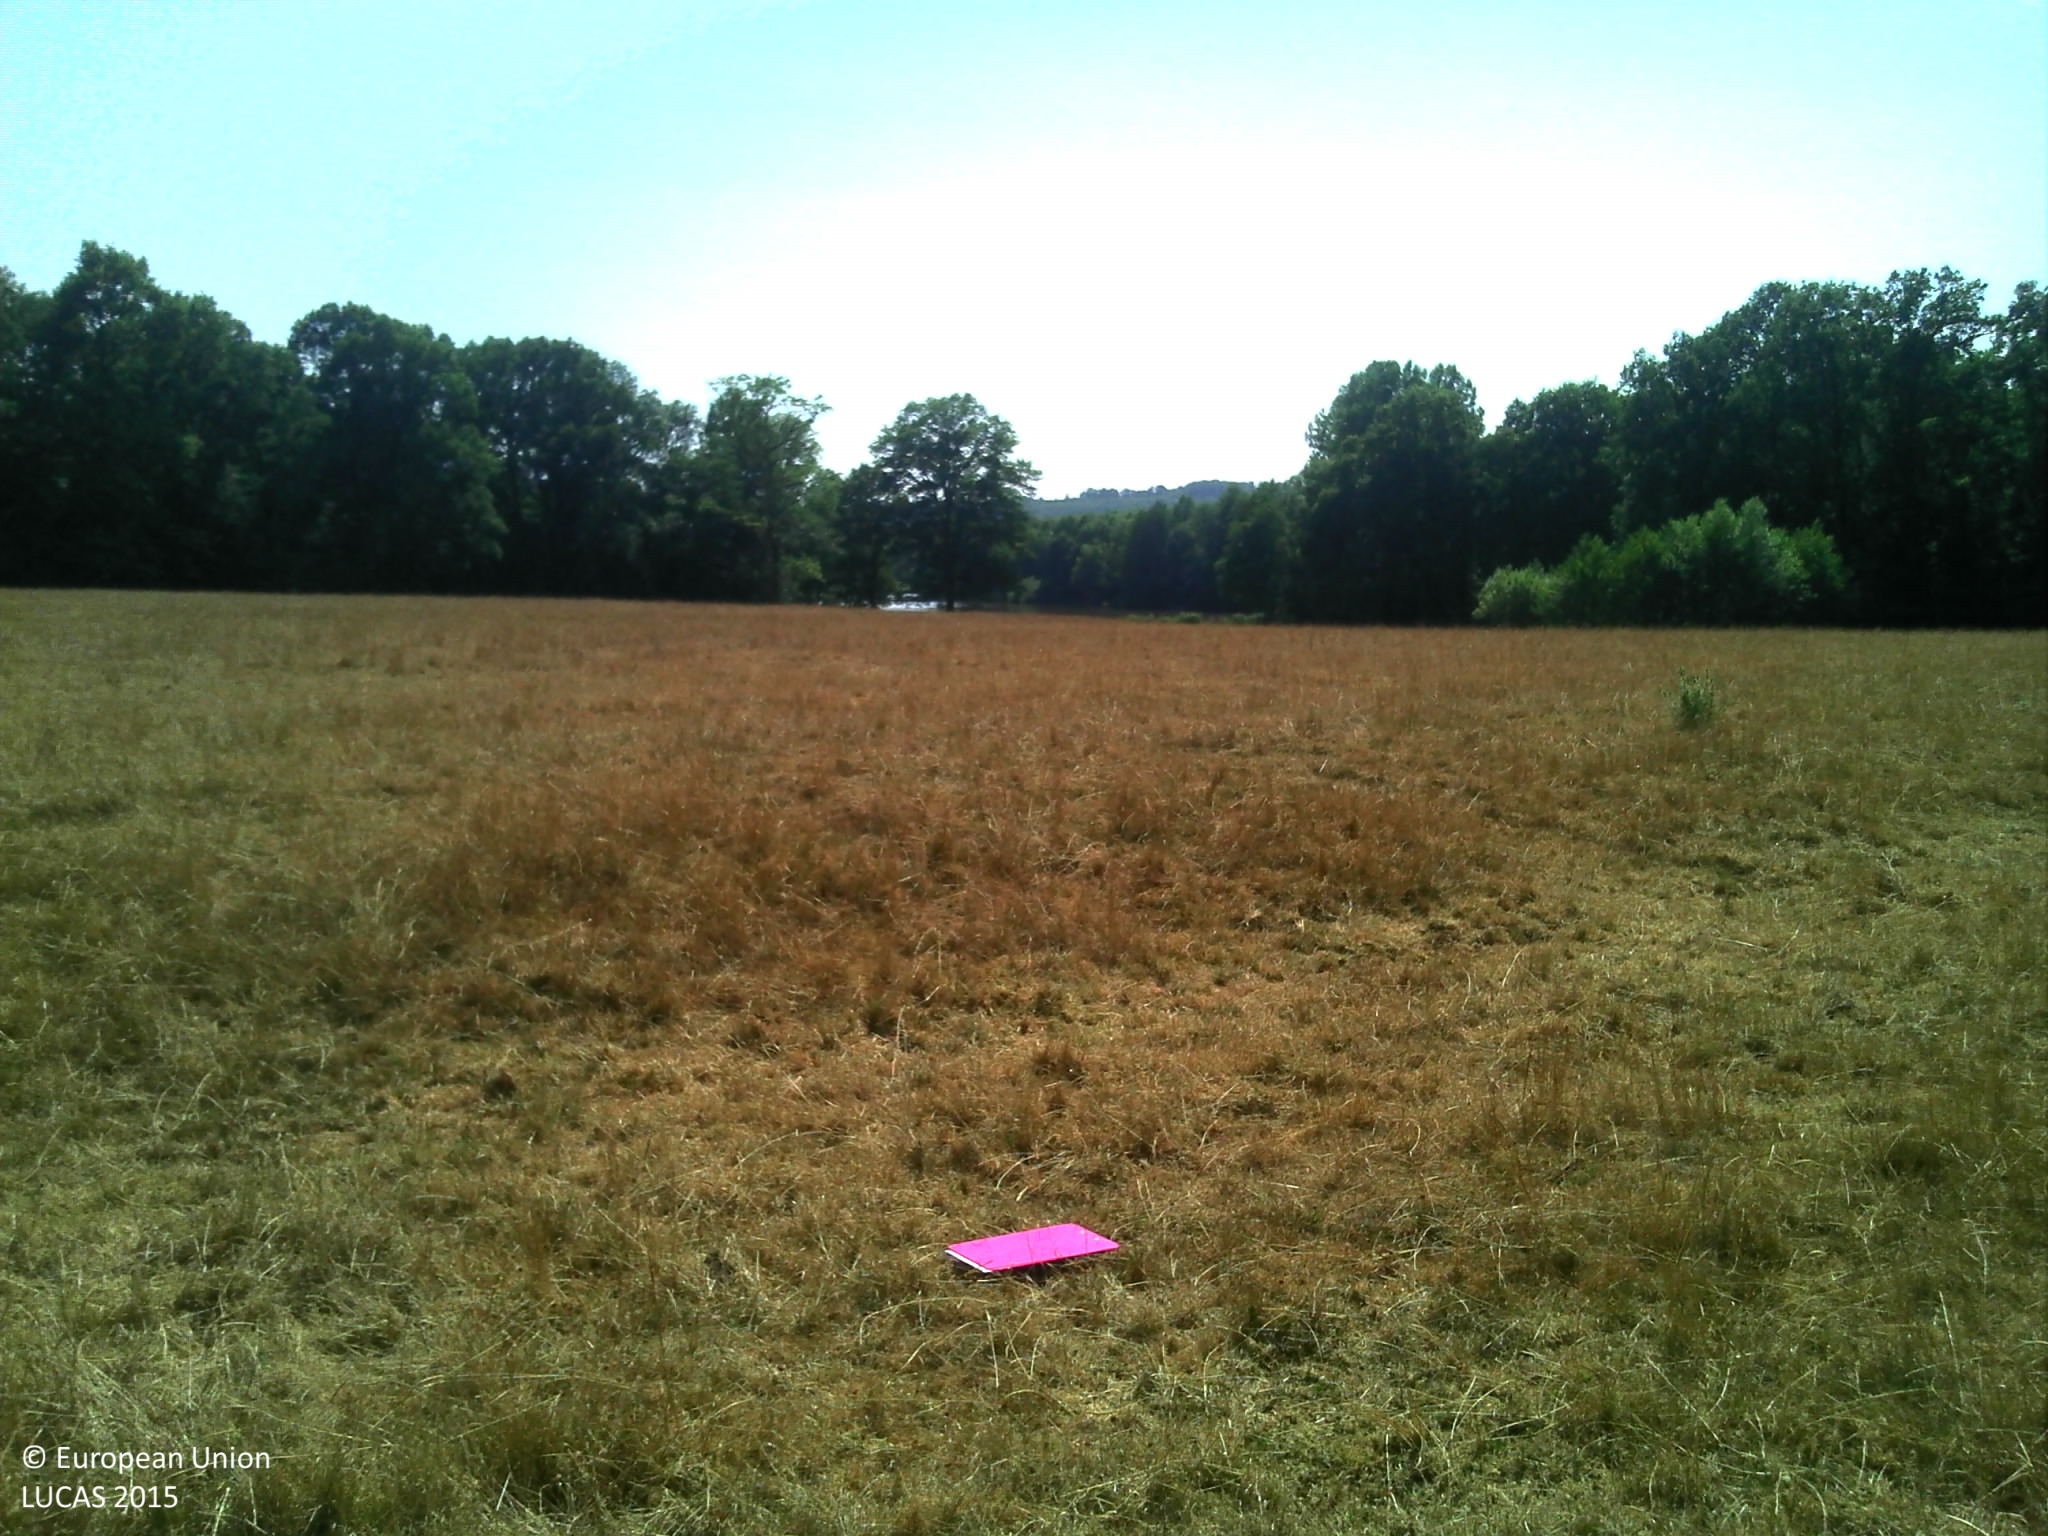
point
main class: Grassland
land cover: Grassland without tree/shrub cover
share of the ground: > 75 %
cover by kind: herbaceous plants 100 %
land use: Agriculture (excluding fallow land and kitchen gardens)
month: July
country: FR
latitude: 49.0525
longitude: 5.1132
